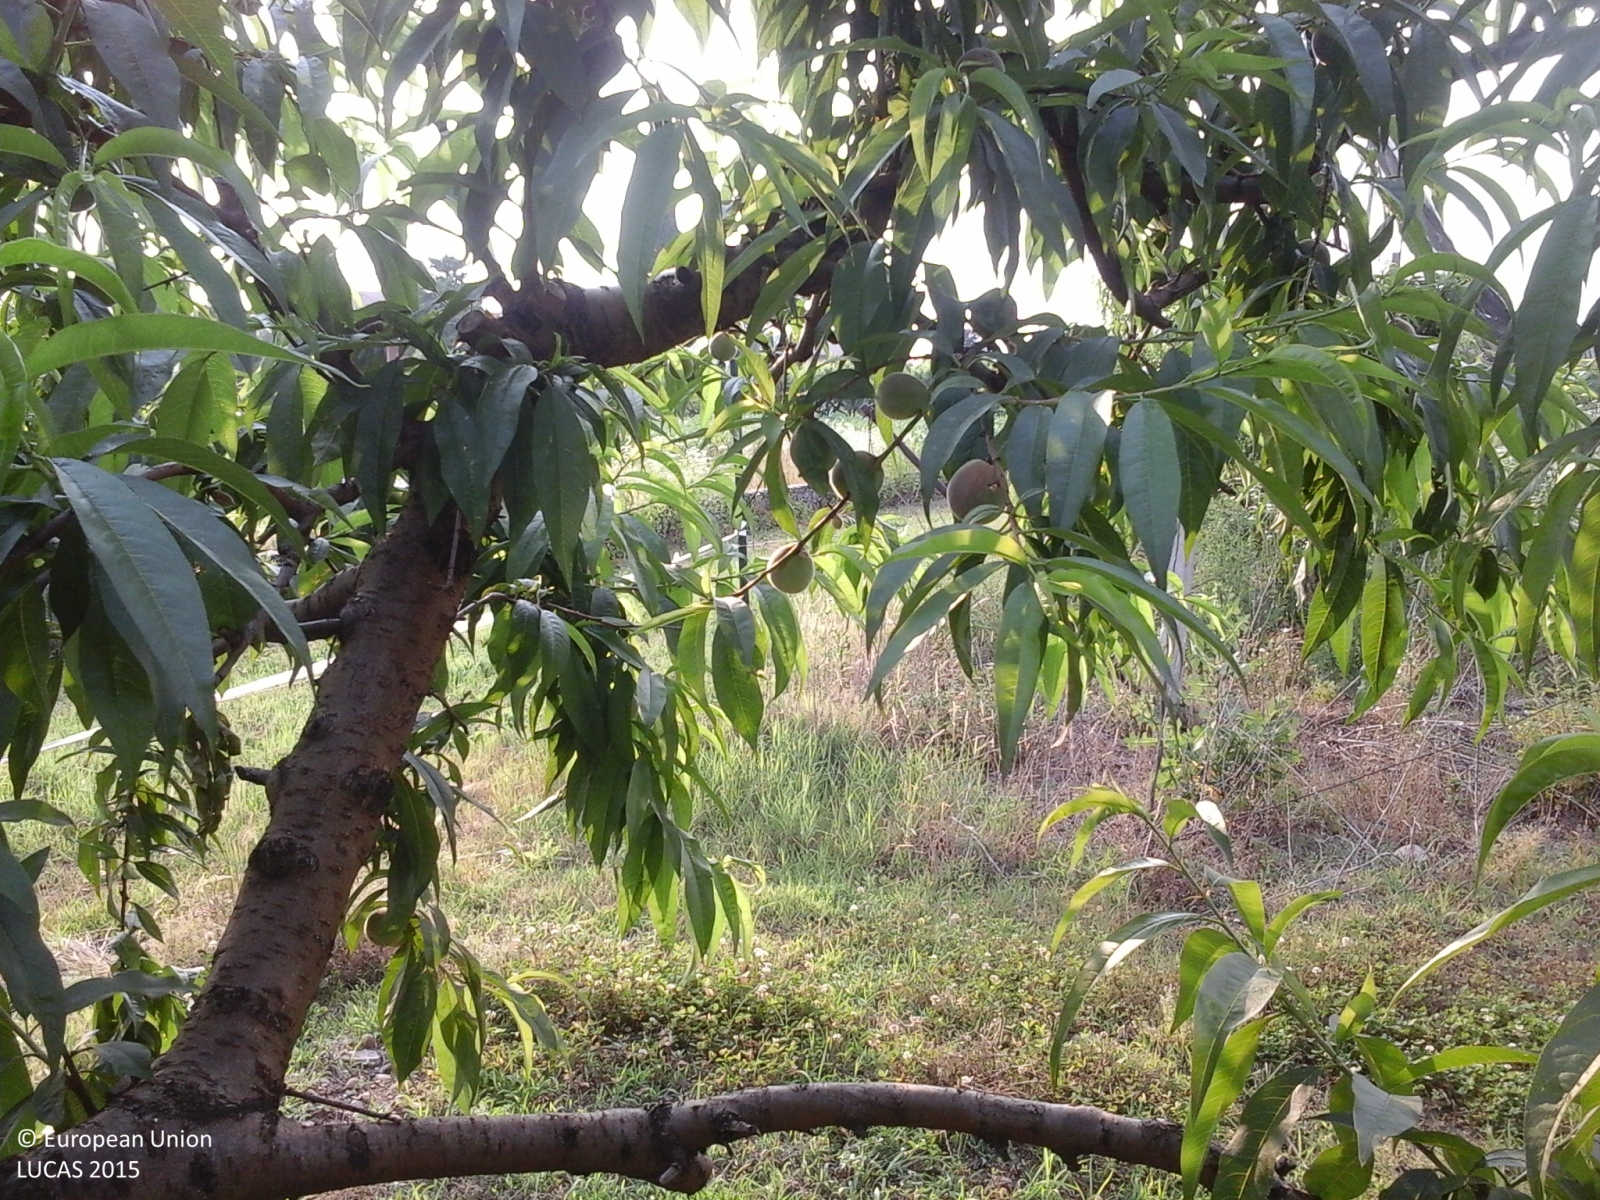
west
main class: Cropland
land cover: Other fruit trees and berries
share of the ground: 50 - 75 %
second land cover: Grassland without tree/shrub cover
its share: > 75 %
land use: Agriculture (excluding fallow land and kitchen gardens)
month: June
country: IT
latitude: 45.5011
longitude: 10.8305
